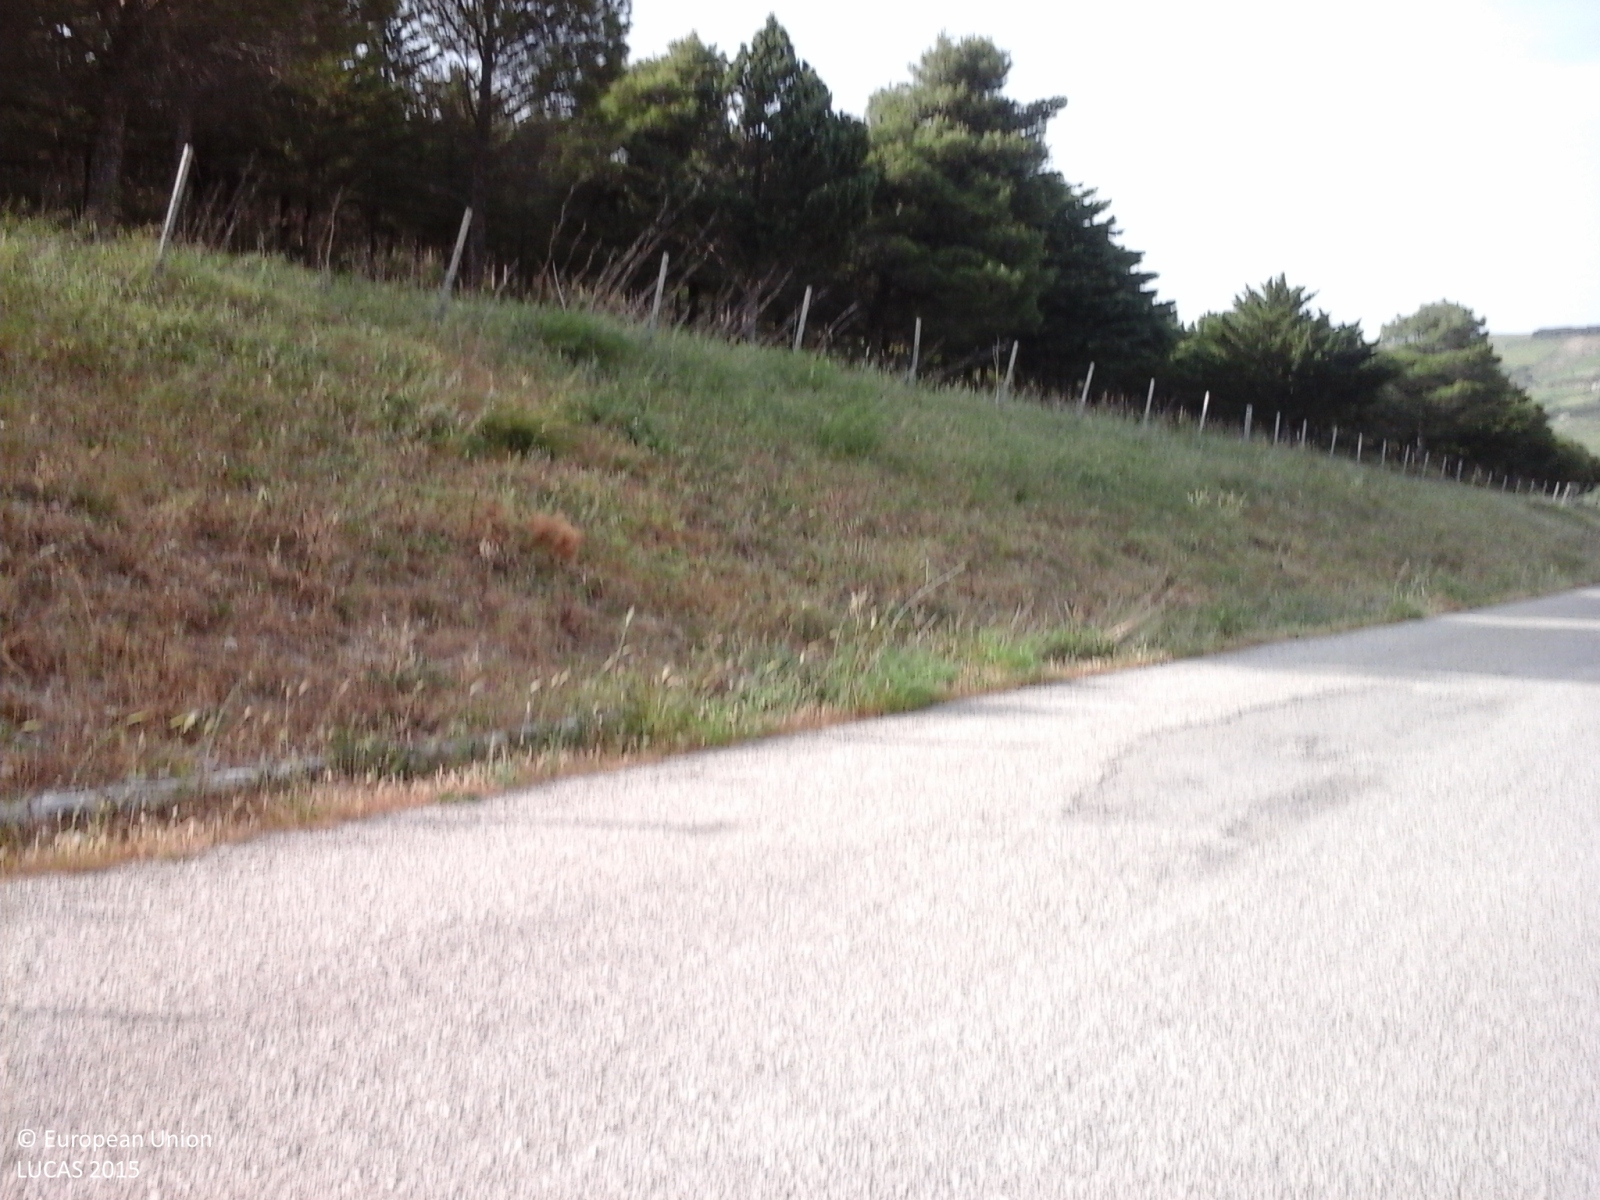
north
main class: Cropland
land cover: Other fruit trees and berries
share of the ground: > 75 %
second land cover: Other bare soil
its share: > 75 %
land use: Agriculture (excluding fallow land and kitchen gardens)
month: May
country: IT
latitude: 37.6806
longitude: 13.5680
